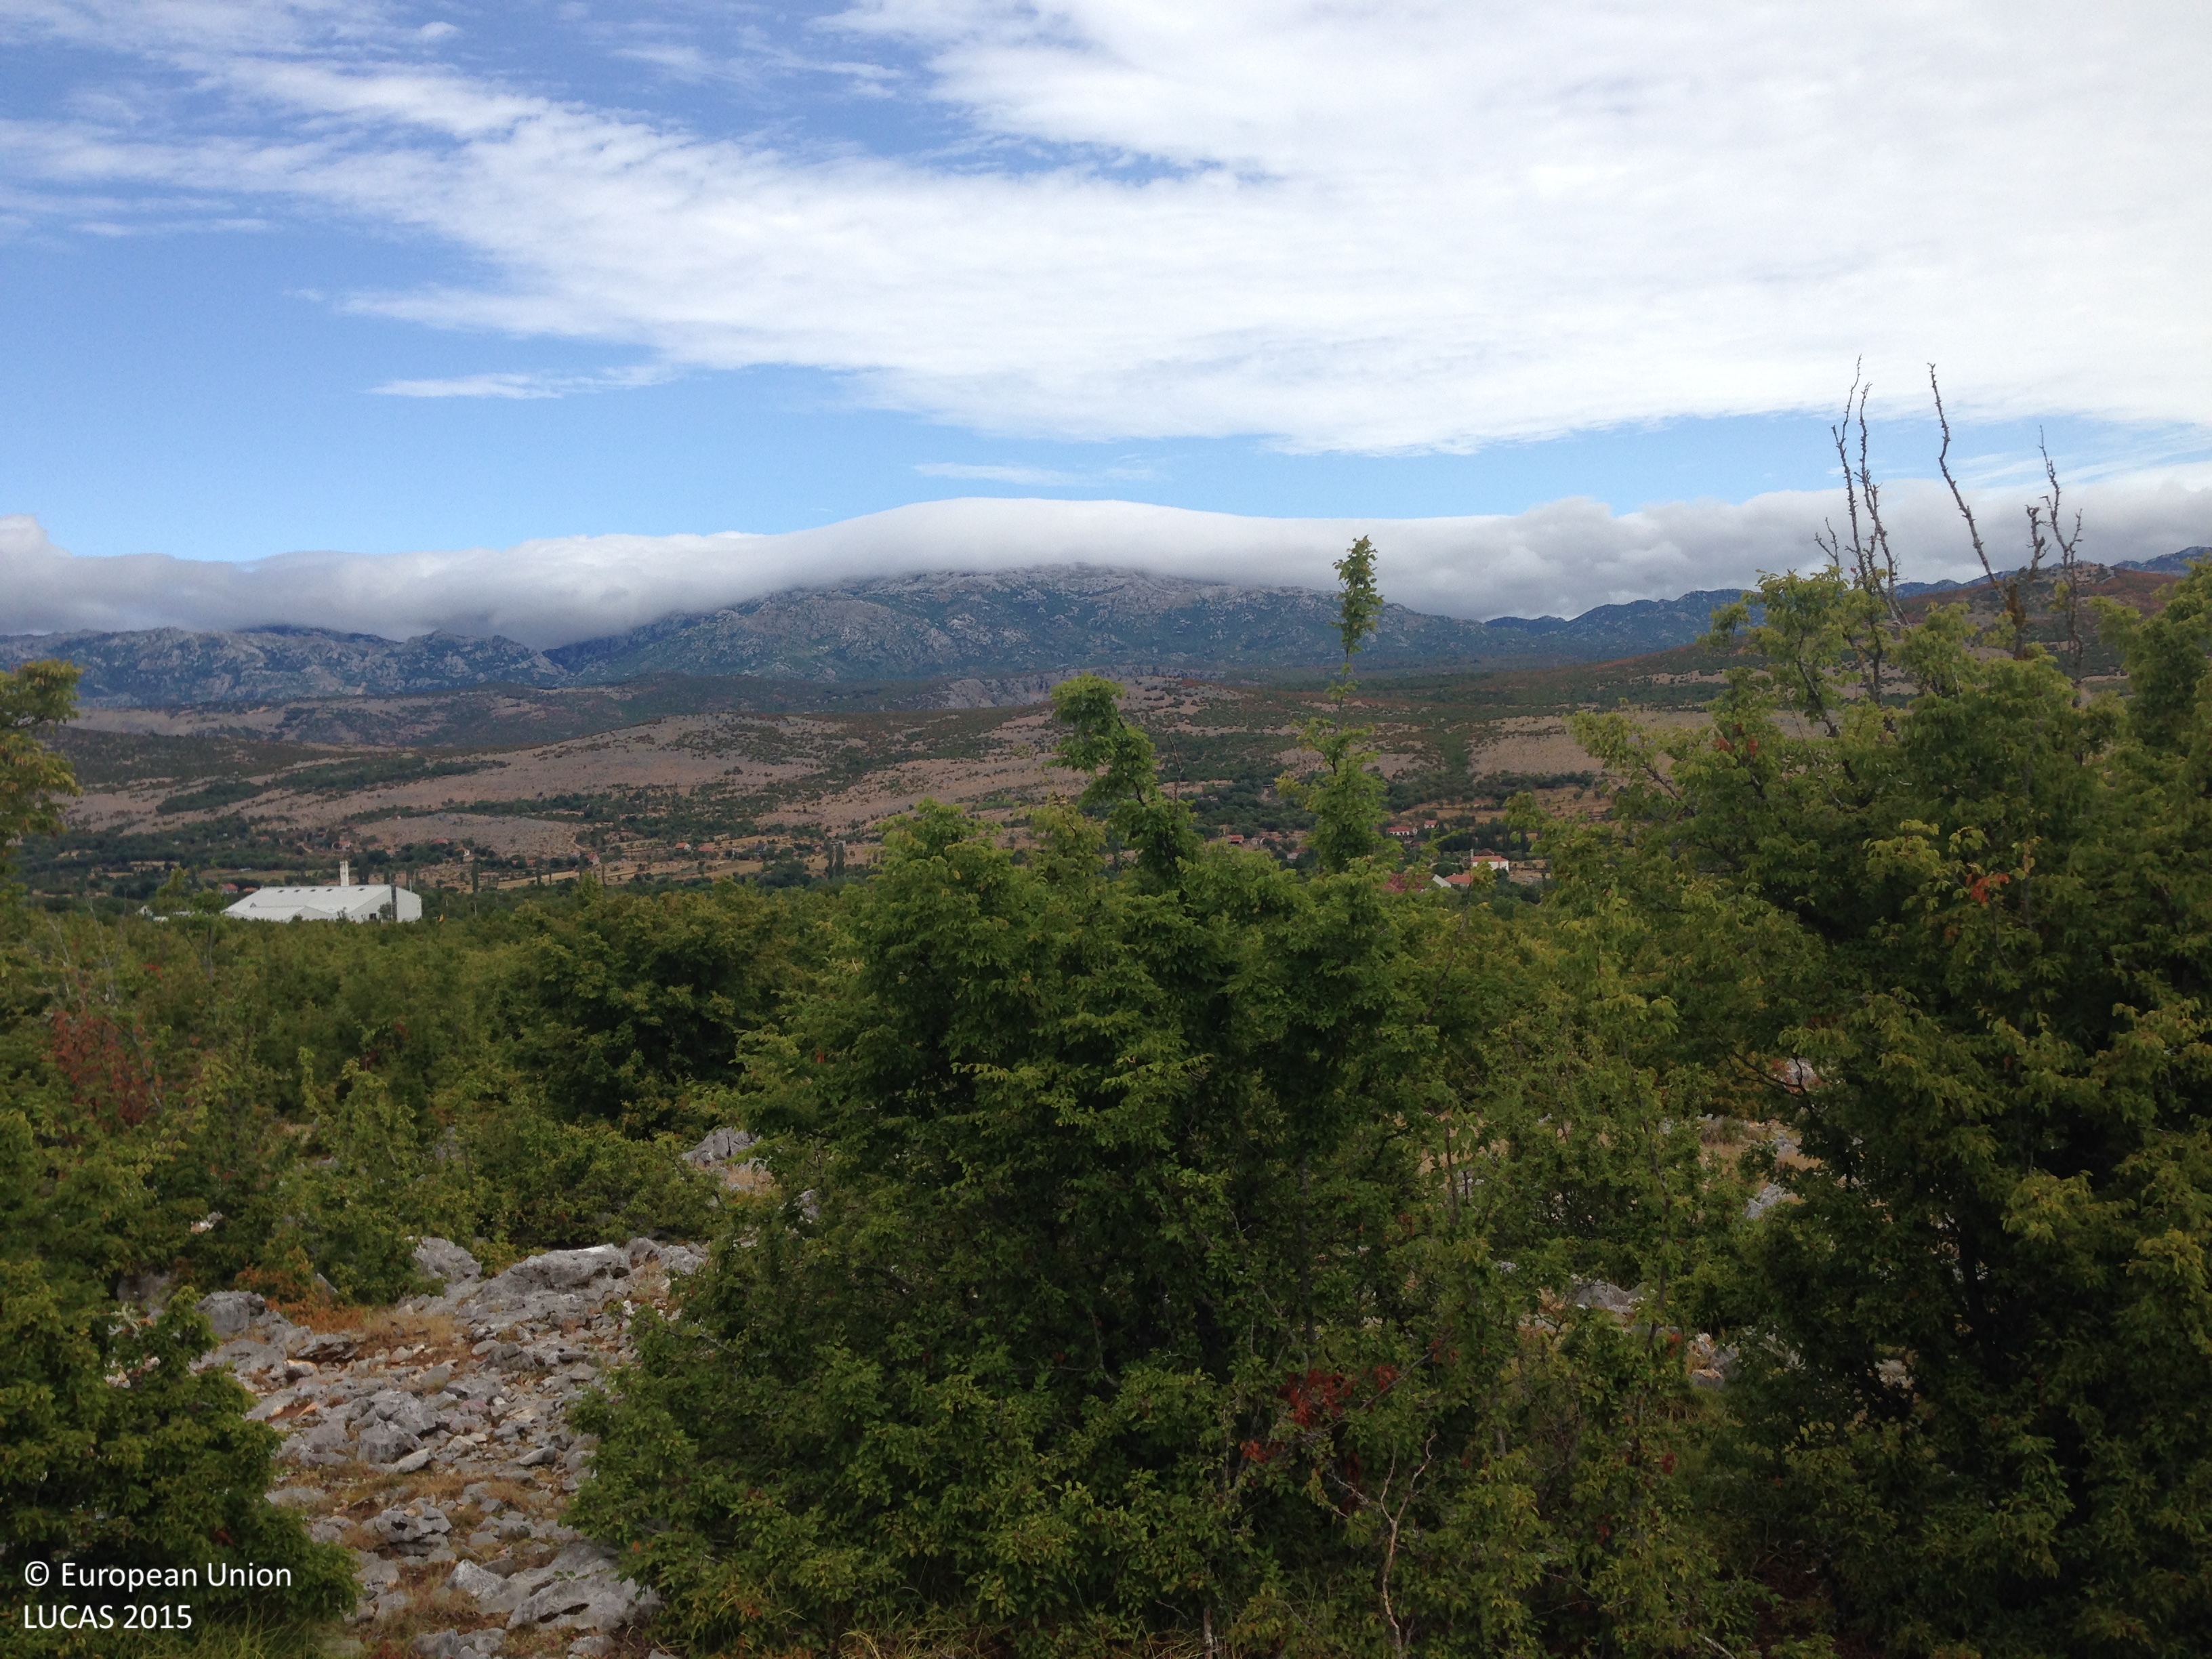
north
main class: Woodland
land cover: Broadleaved woodland
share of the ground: 50 - 75 %
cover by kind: broadleaved forest trees 55 %, unconsolidated bare surface 15 %, shrubs 10 %, herbaceous plants 10 %, consolidated bare surface 10 %
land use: Semi-natural and natural areas not in use
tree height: < 5 m
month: July
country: HR
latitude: 44.1490
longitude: 15.8560
